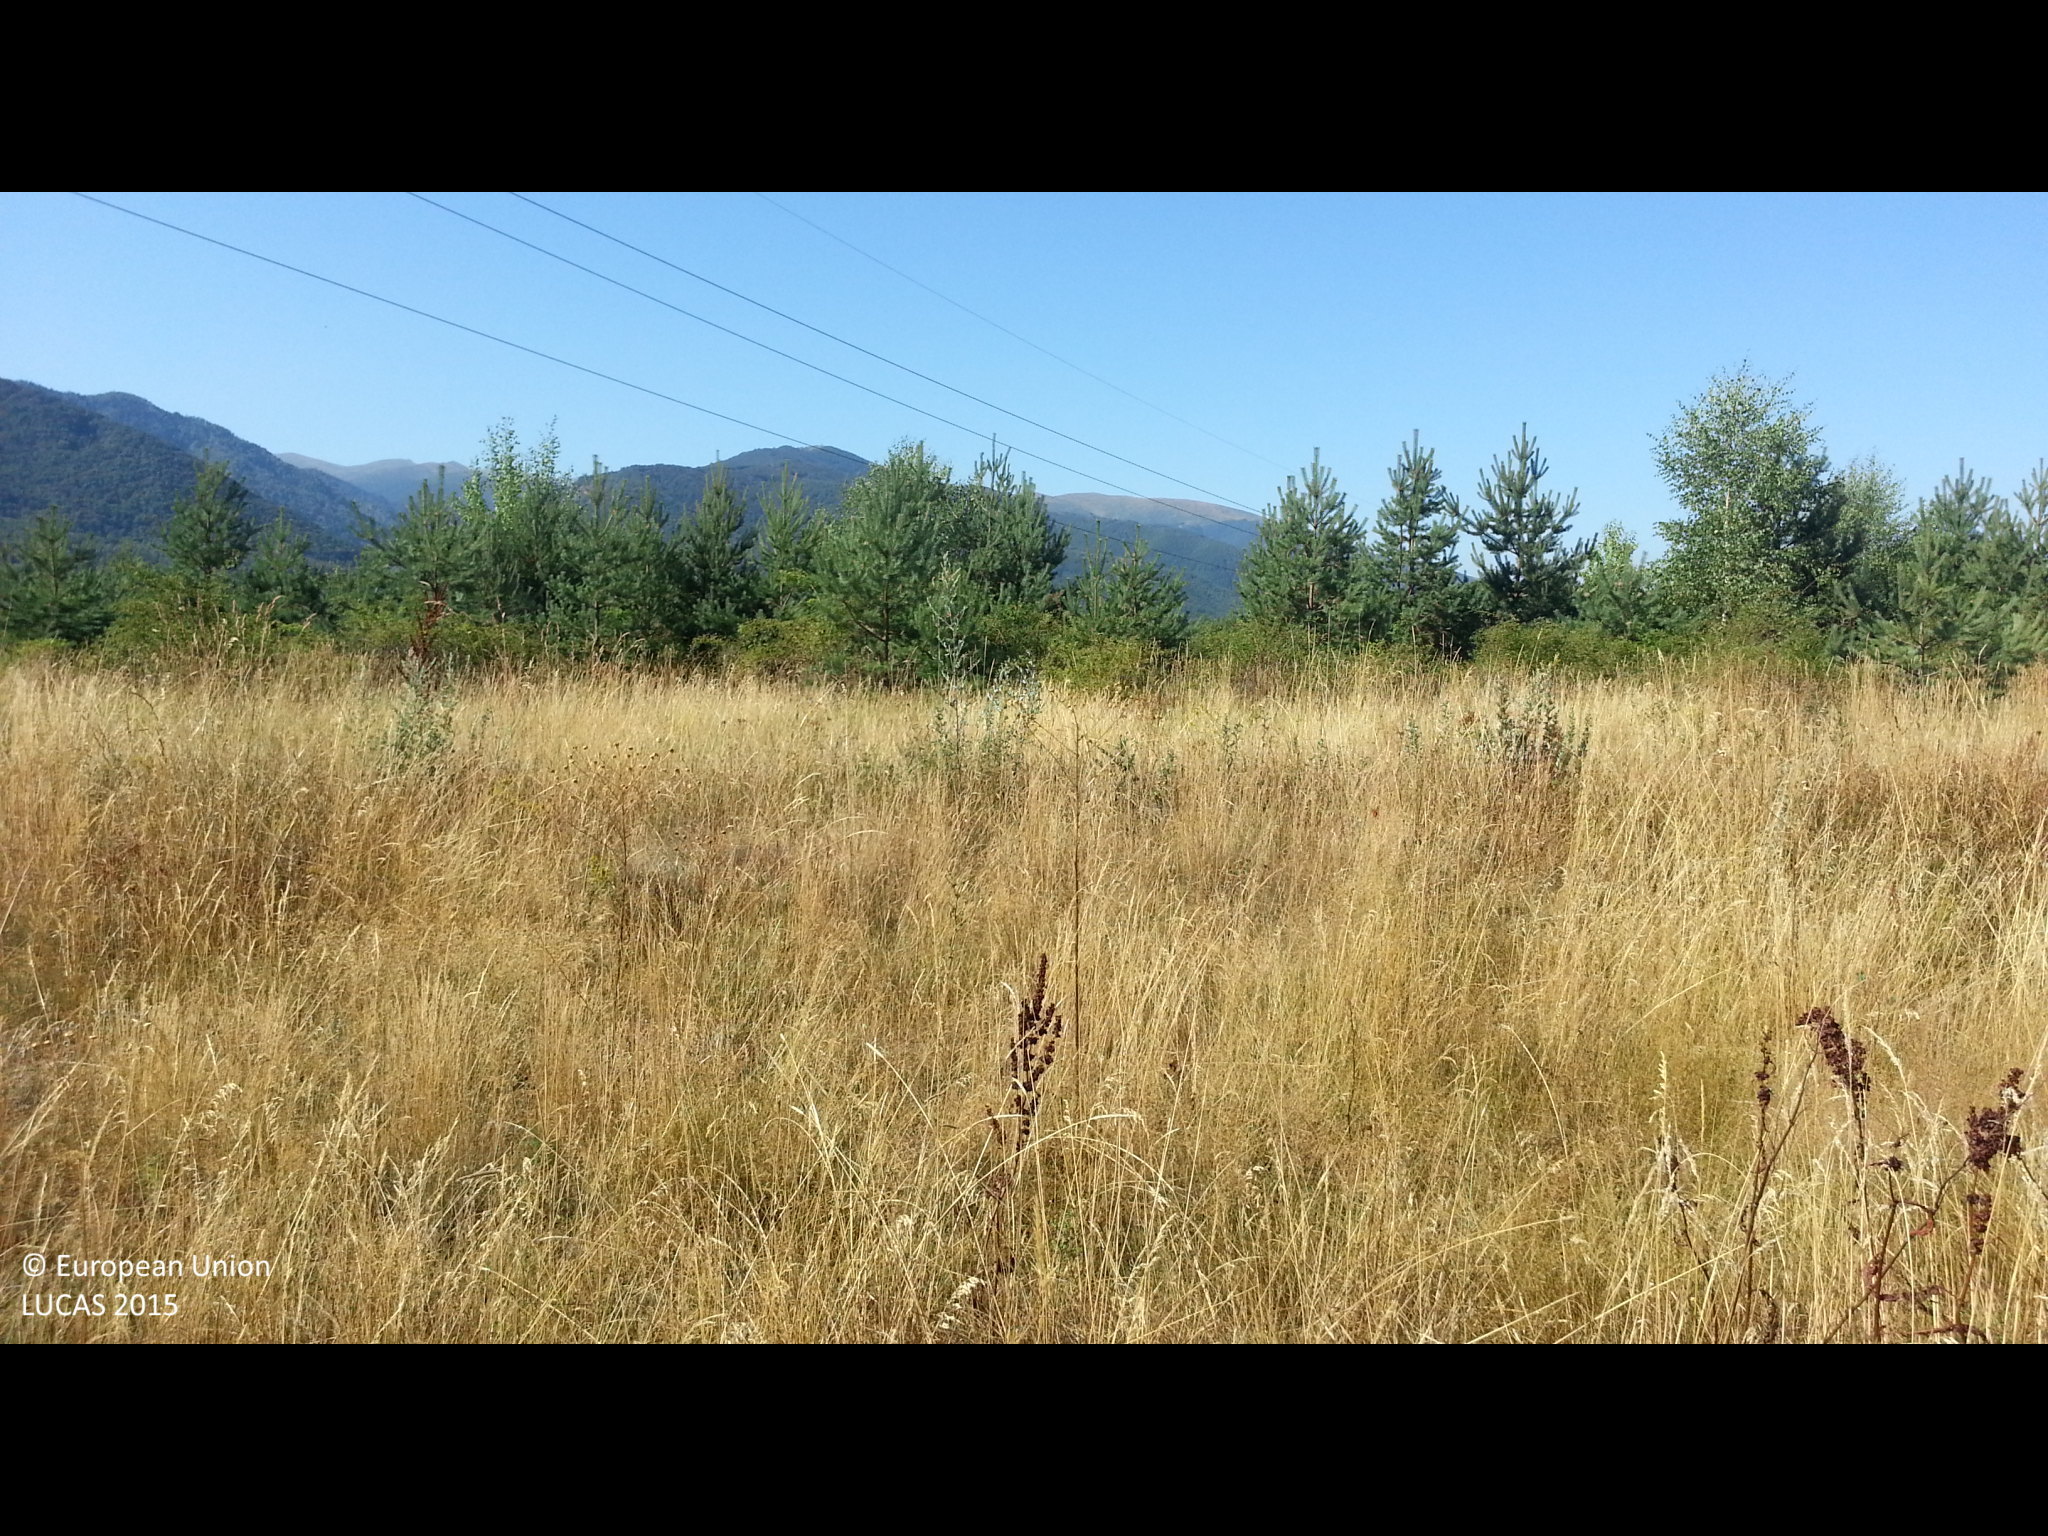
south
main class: Grassland
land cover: Grassland with sparse tree/shrub cover
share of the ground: > 75 %
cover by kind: herbaceous plants 90 %, broadleaved forest trees 5 %, shrubs 5 %
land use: Agriculture (excluding fallow land and kitchen gardens)
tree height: > 5 m
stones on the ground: < 10 %
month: August
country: BG
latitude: 42.2694
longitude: 22.5685
